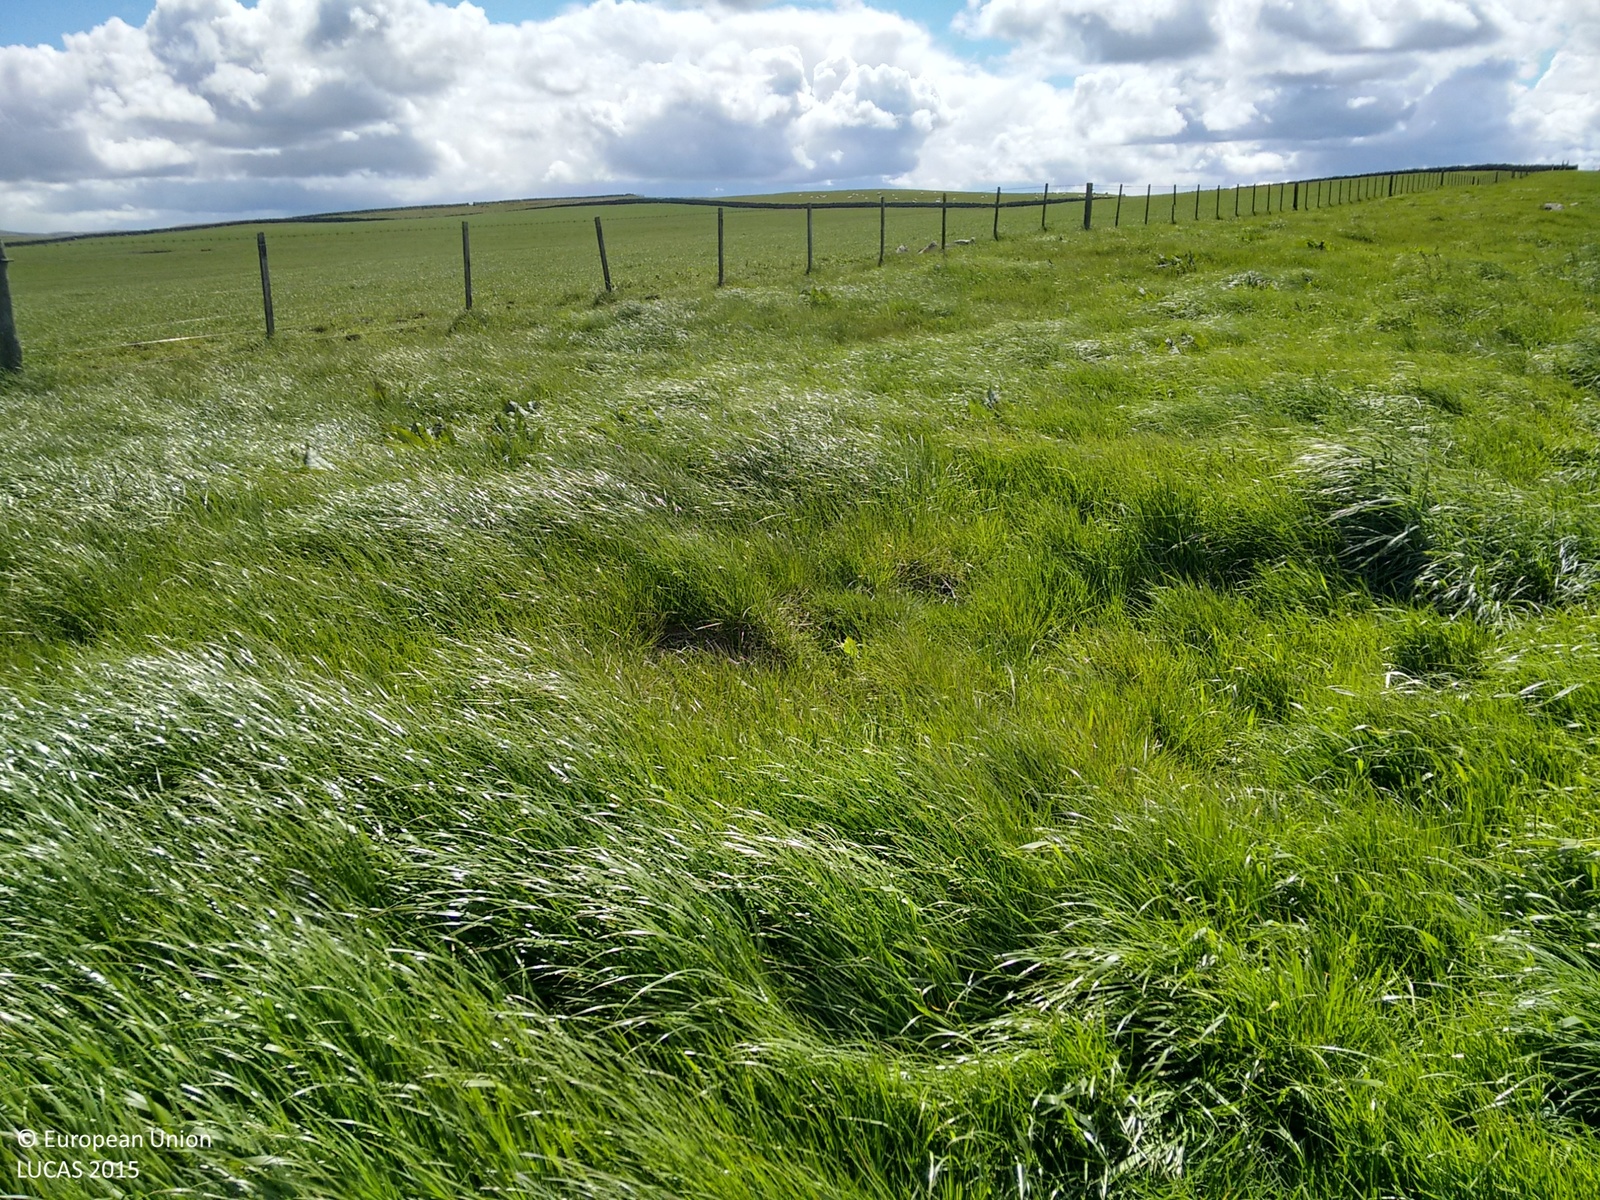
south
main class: Grassland
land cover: Grassland without tree/shrub cover
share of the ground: > 75 %
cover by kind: herbaceous plants 100 %
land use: Agriculture (excluding fallow land and kitchen gardens)
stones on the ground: < 10 %
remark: Harvested field
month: May
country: GB
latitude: 55.4727
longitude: -2.4149
